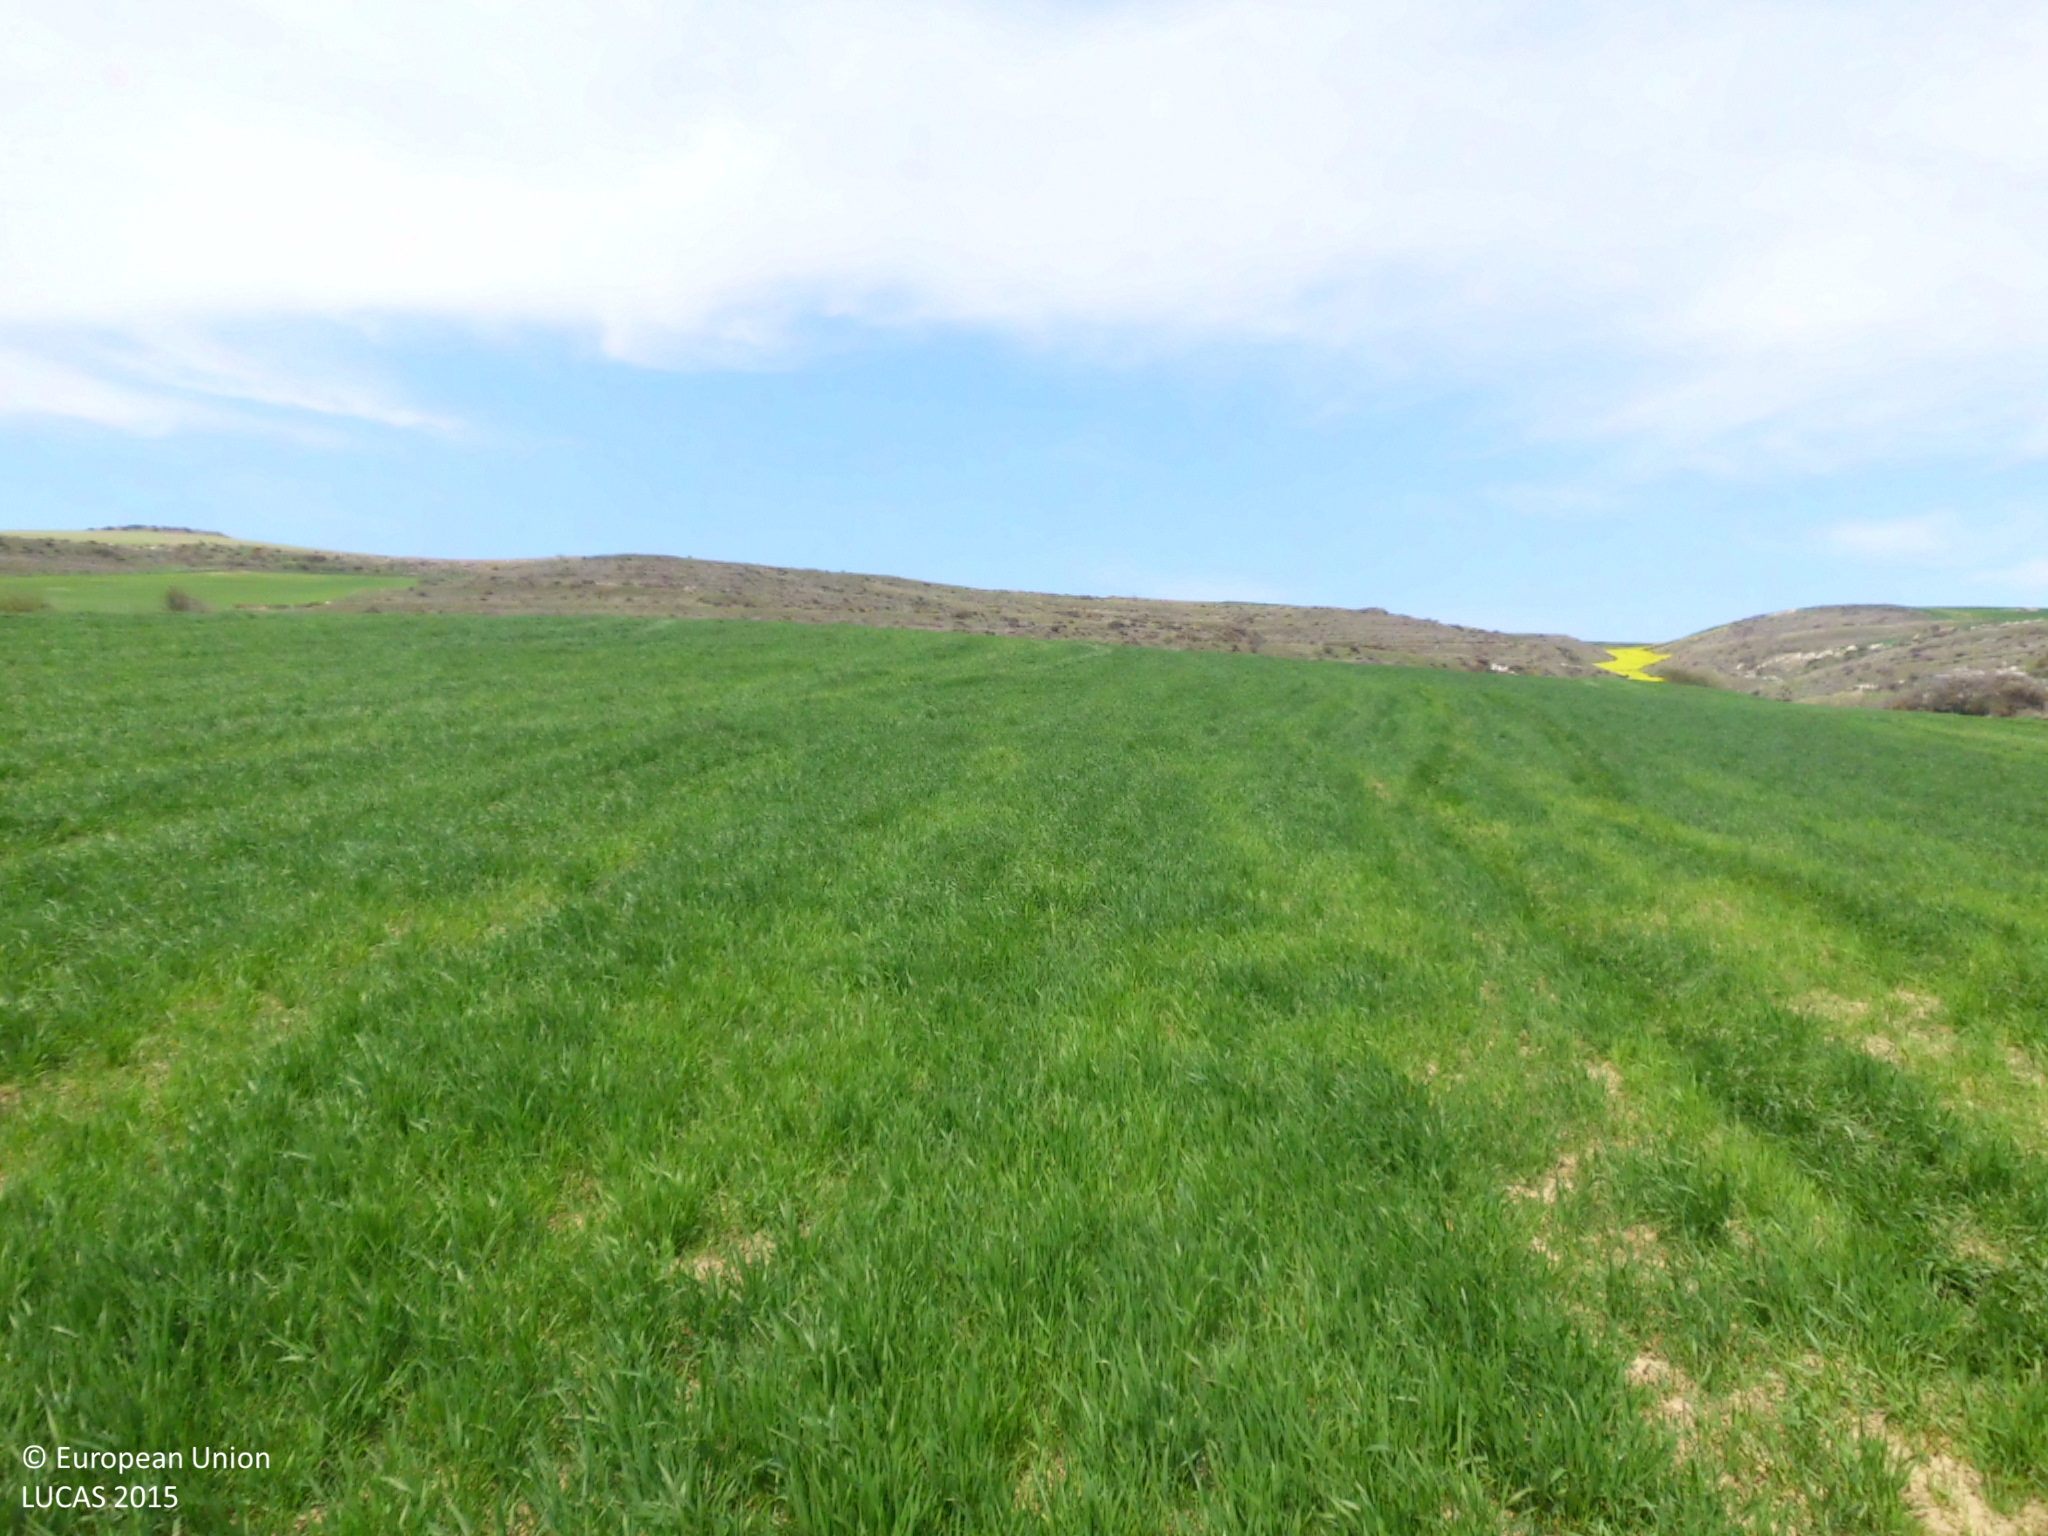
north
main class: Cropland
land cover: Barley
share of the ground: > 75 %
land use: Agriculture (excluding fallow land and kitchen gardens)
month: April
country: ES
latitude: 42.4138
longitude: -3.2886
